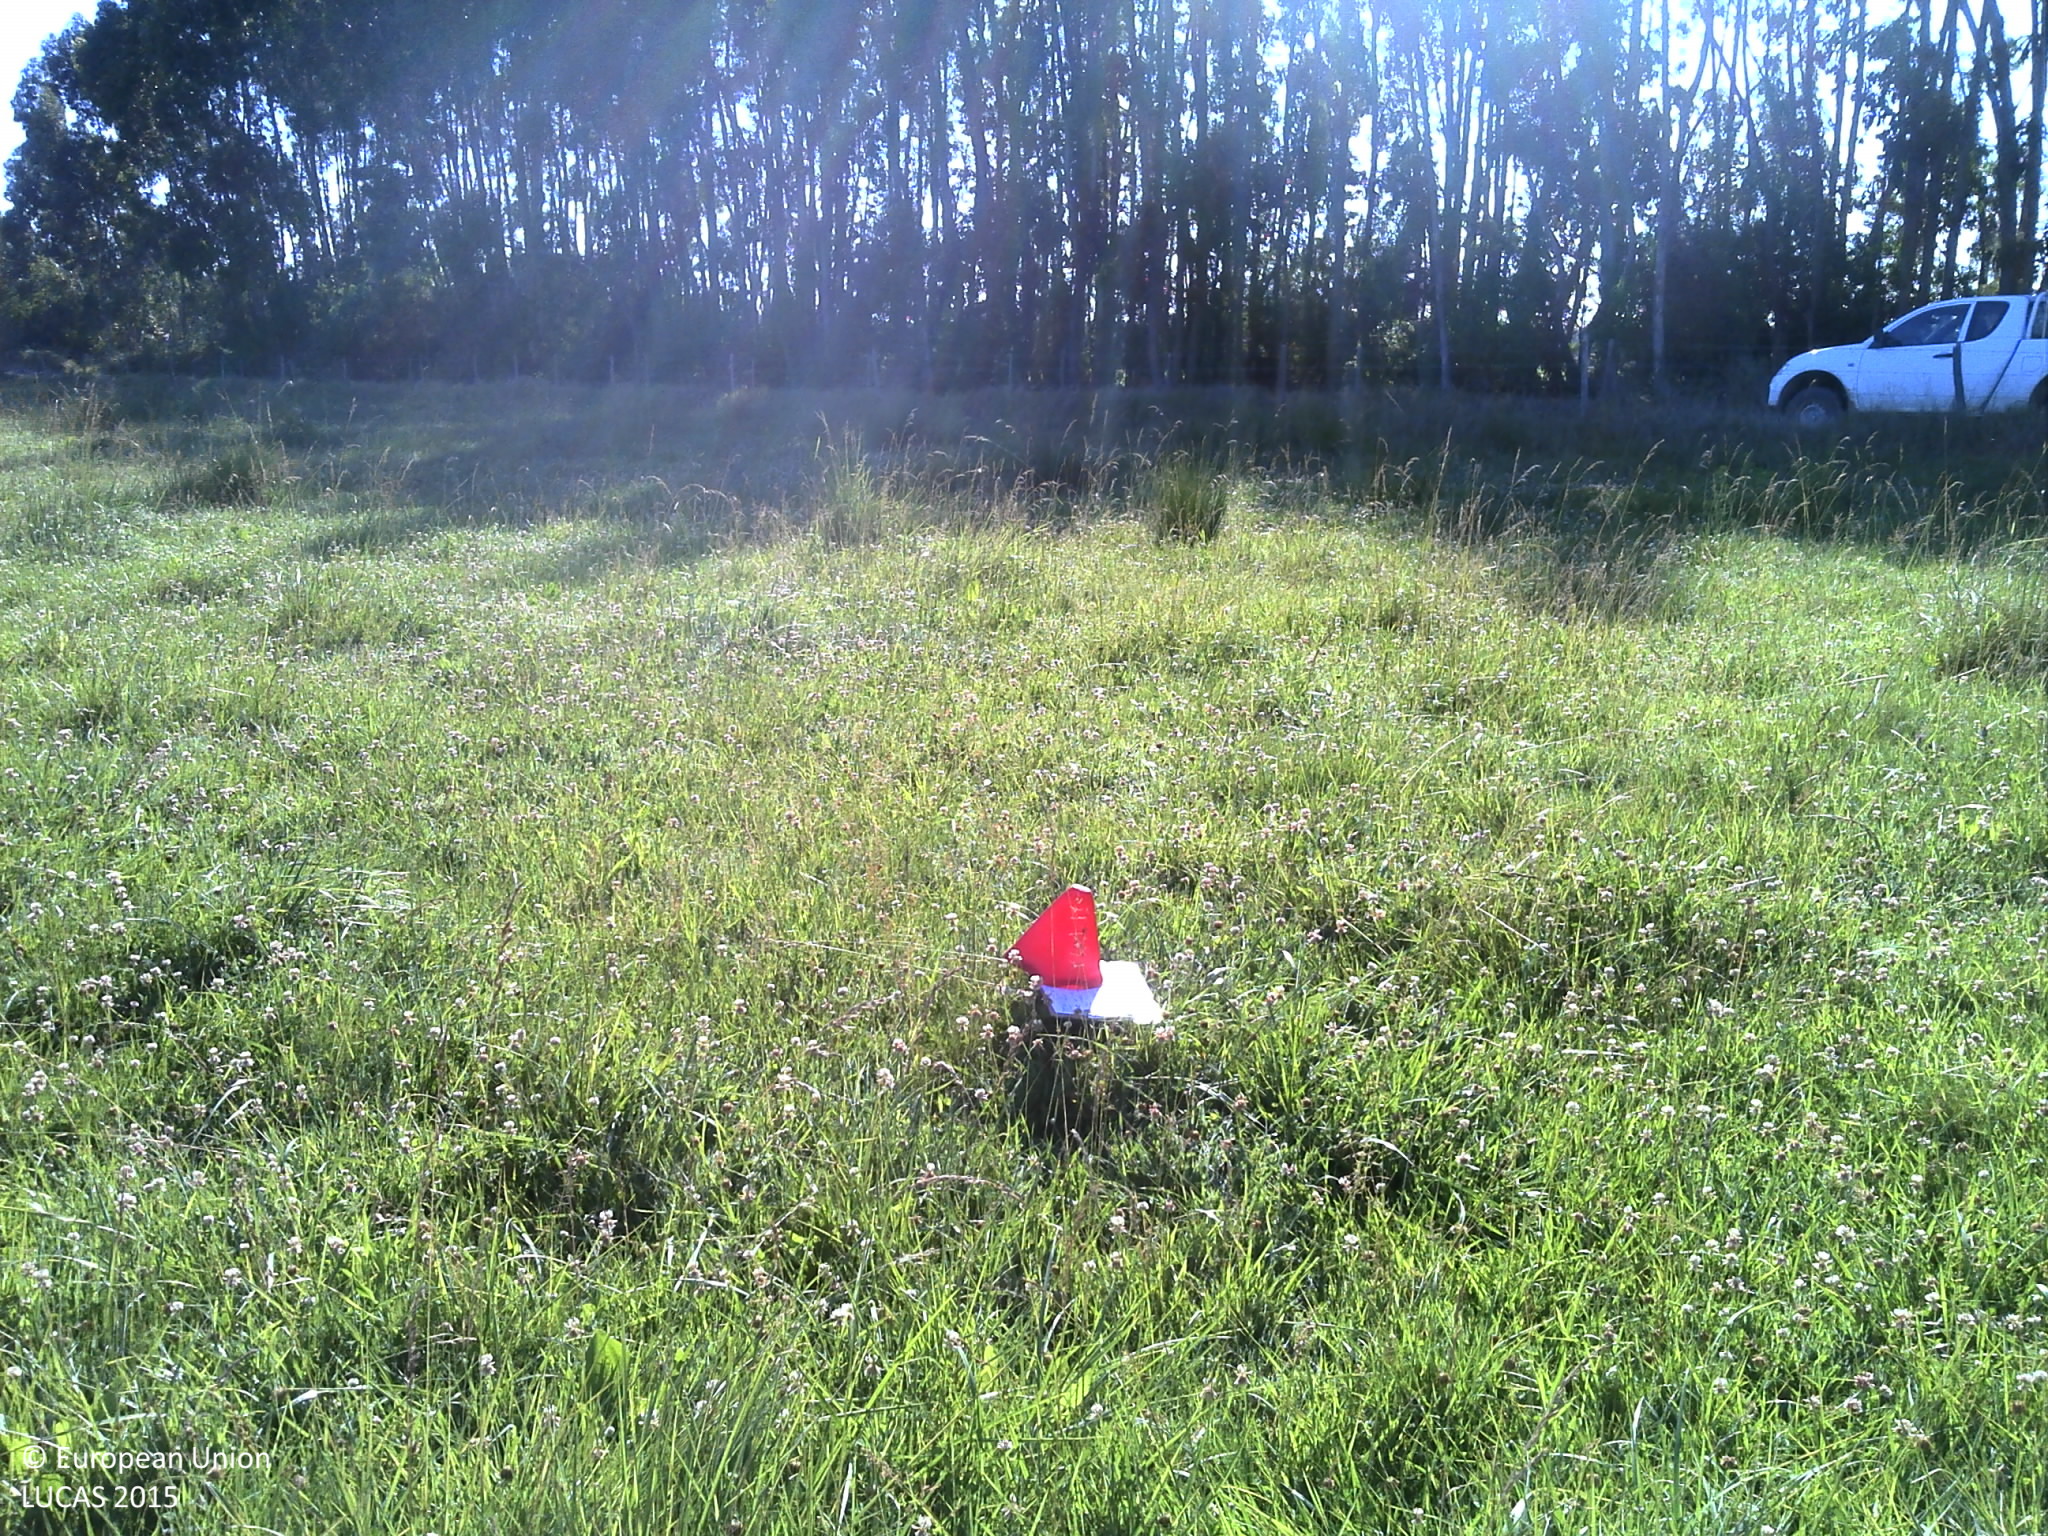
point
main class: Cropland
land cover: Temporary grasslands
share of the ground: > 75 %
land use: Agriculture (excluding fallow land and kitchen gardens)
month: June
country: PT
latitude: 37.4772
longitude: -8.7533
